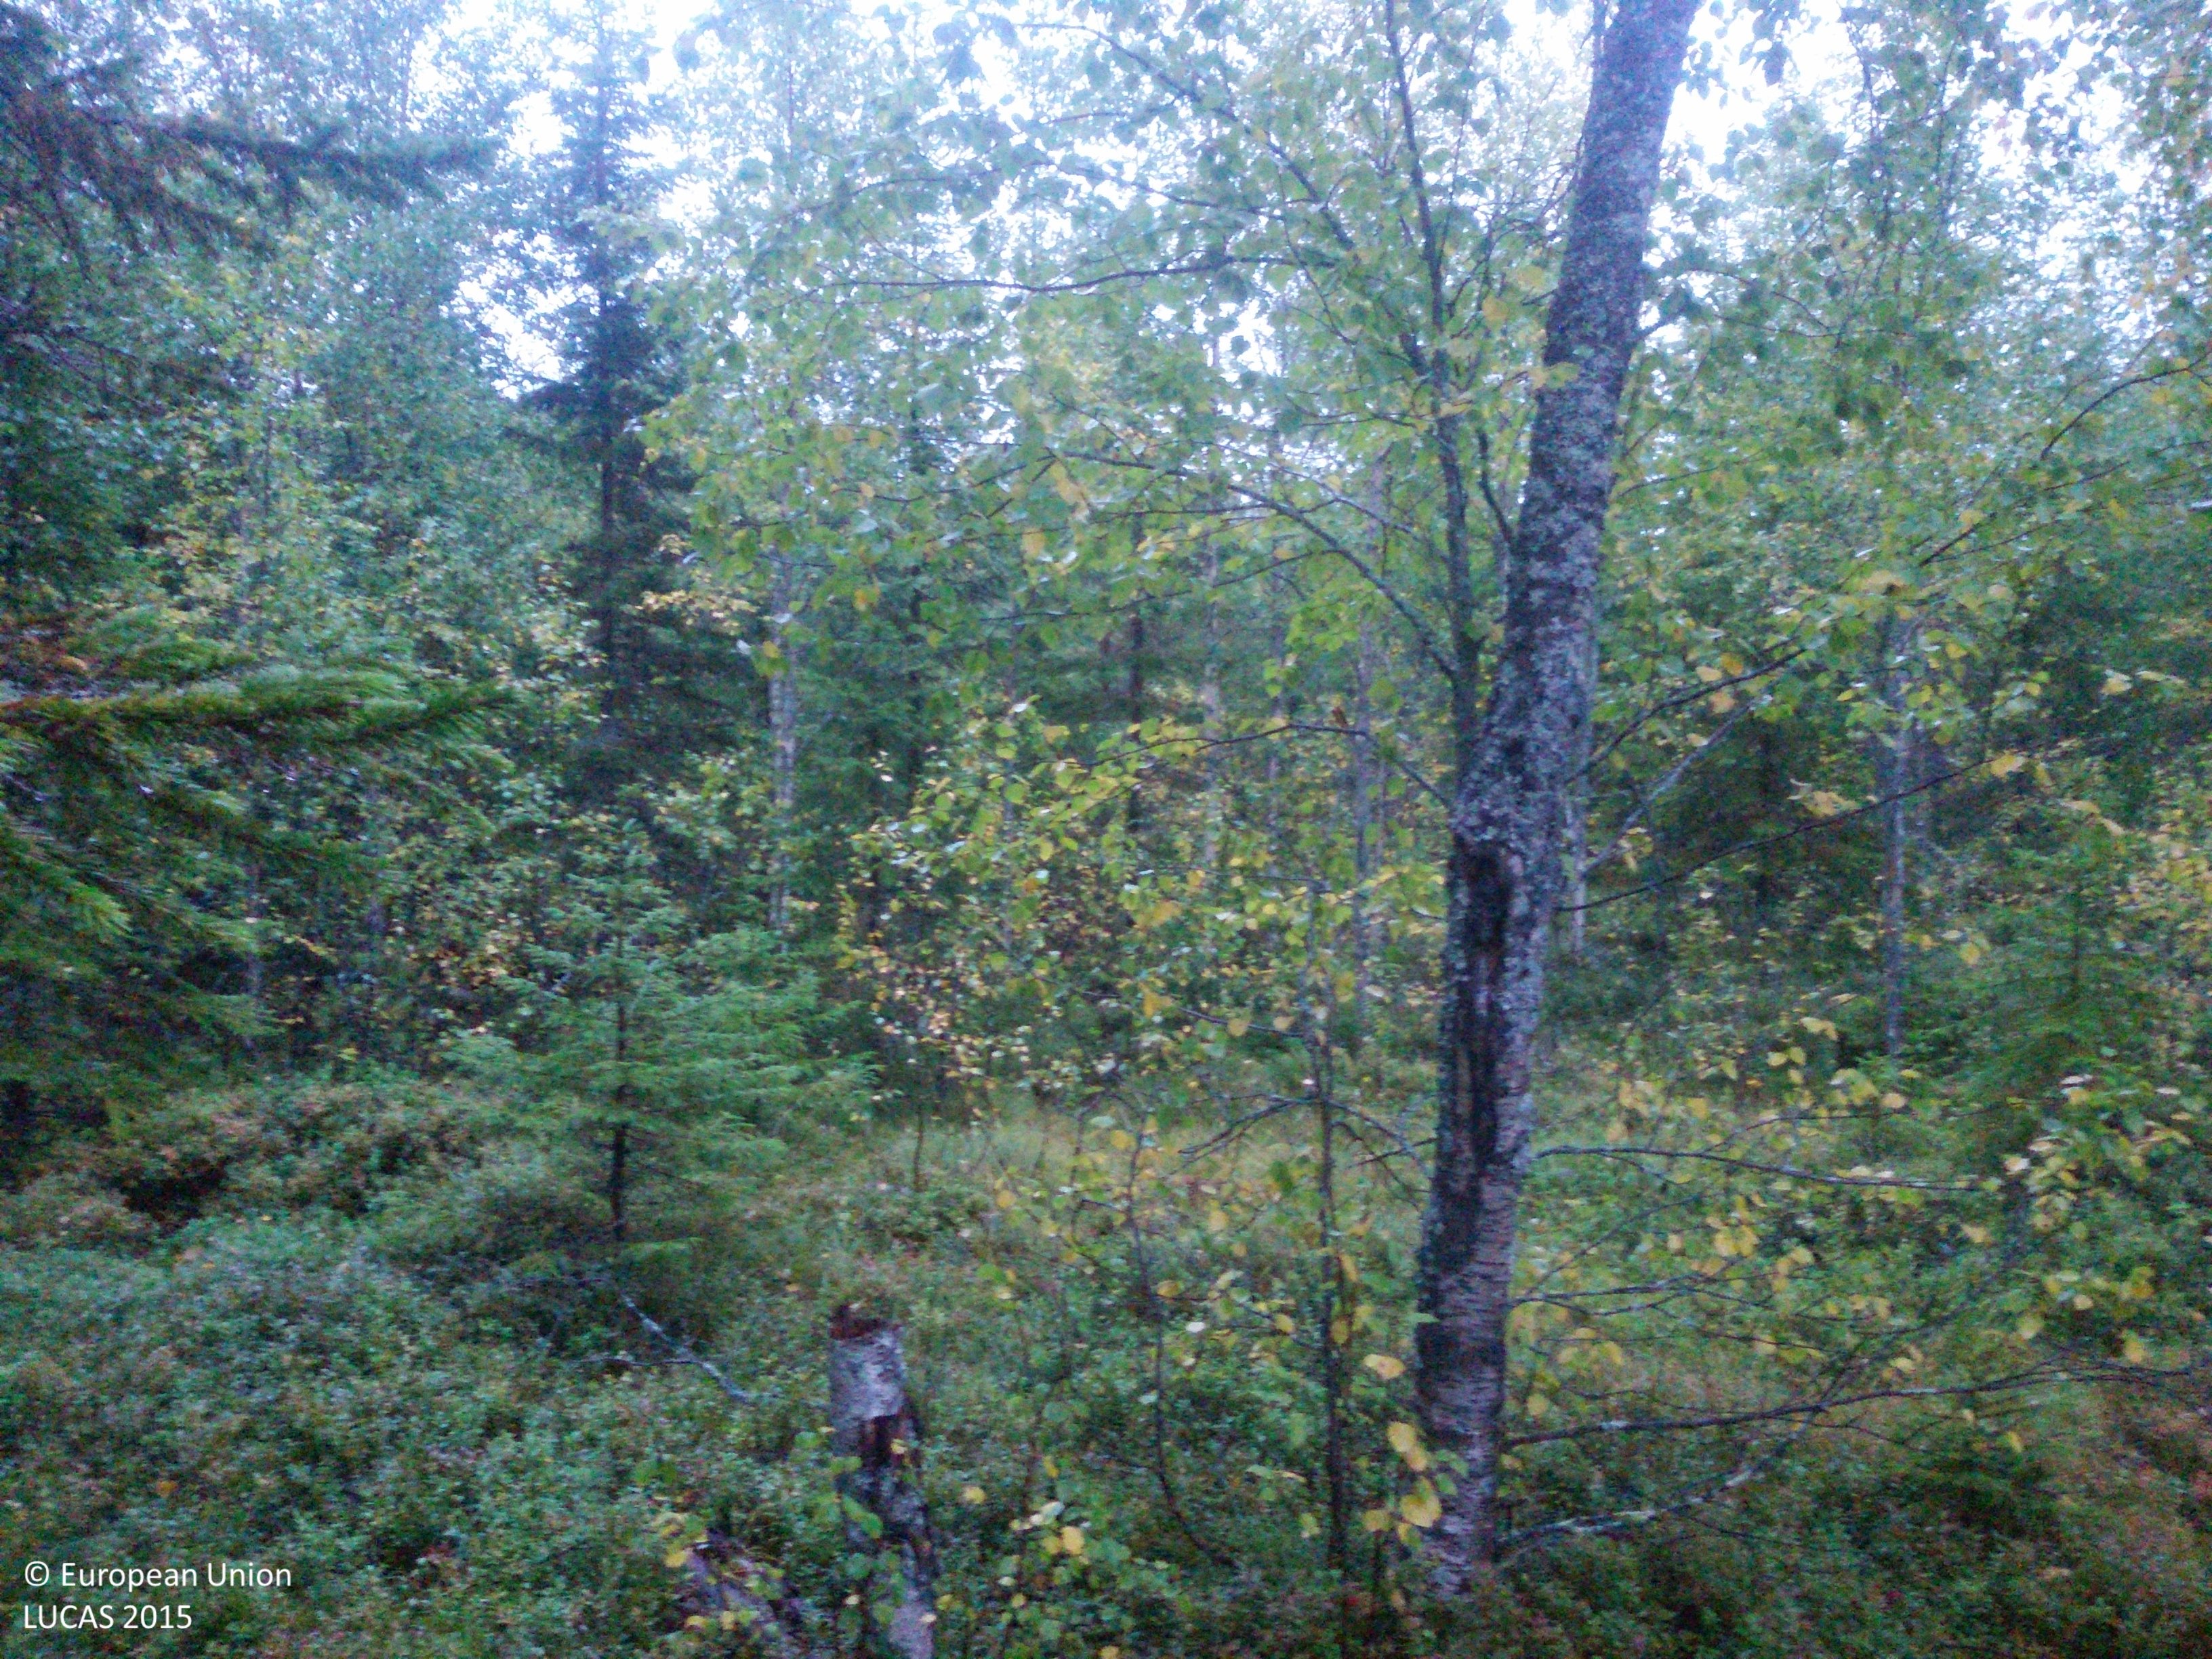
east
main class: Woodland
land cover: Spruce dominated mixed woodland
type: boreal forest
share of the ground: > 75 %
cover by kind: coniferous forest trees 40 %, broadleaved forest trees 30 %, herbaceous plants 20 %, lichens and mosses 10 %
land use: Forestry
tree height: > 5 m
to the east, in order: Spruce dominated mixed woodland; Spruce dominated coniferous woodland; Broadleaved woodland; Rivers and streams; Spruce dominated coniferous woodland; Tracks; Spruce dominated mixed woodland; Spruce dominated coniferous woodland; Pine dominated coniferous woodland
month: September
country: SE
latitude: 60.9810
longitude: 14.2928
